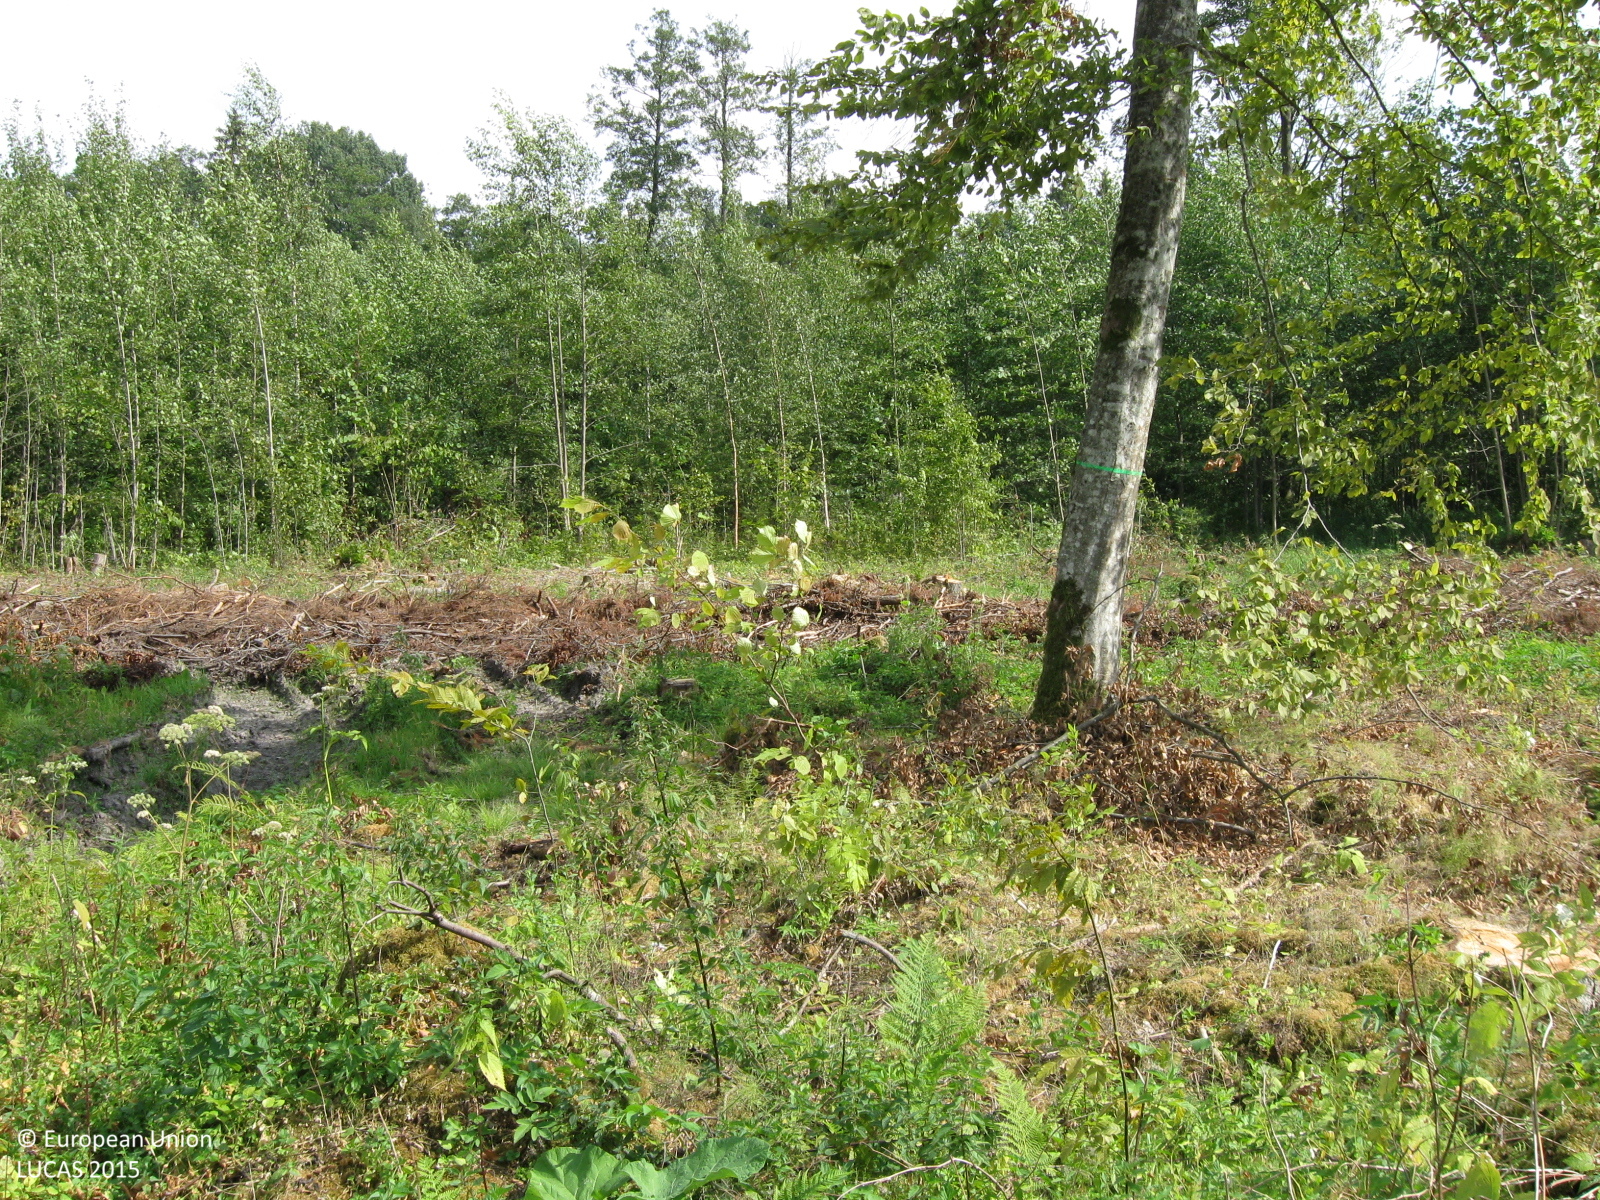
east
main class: Grassland
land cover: Grassland with sparse tree/shrub cover
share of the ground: > 75 %
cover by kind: herbaceous plants 70 %, lichens and mosses 15 %, broadleaved forest trees 5 %, shrubs 5 %, unconsolidated bare surface 5 %
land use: Forestry
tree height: > 5 m
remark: Clear cut
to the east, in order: Grassland with sparse tree/shrub cover; Broadleaved woodland; Spruce dominated mixed woodland; Broadleaved woodland; Spontaneously vegetated surfaces
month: August
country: LT
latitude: 55.2219
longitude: 22.9122
